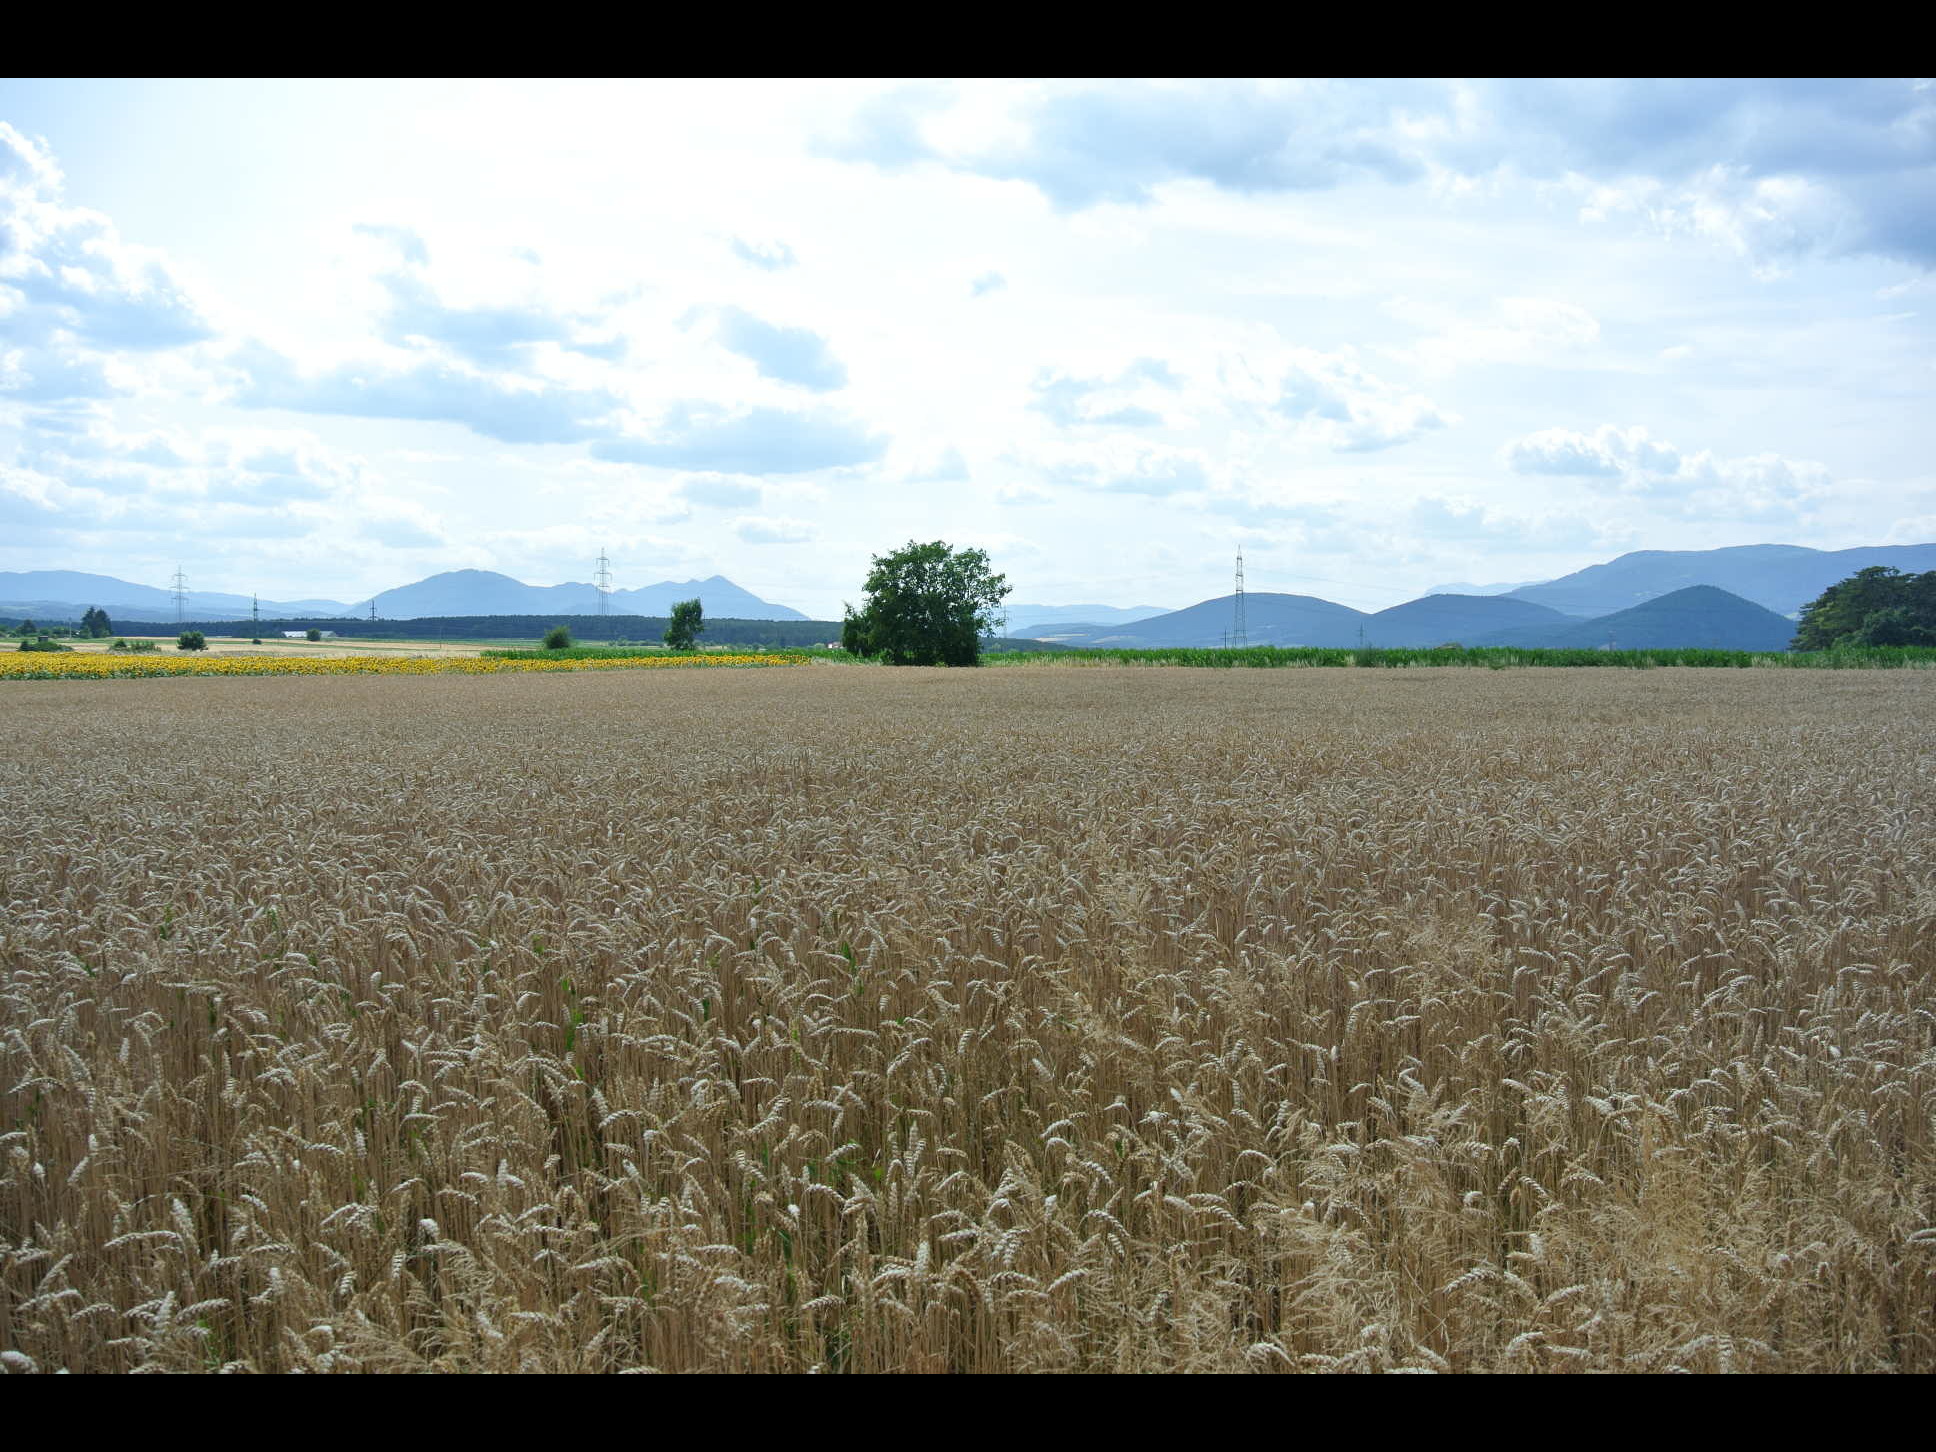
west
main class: Cropland
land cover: Common wheat
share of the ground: > 75 %
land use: Agriculture (excluding fallow land and kitchen gardens)
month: July
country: AT
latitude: 47.7135
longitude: 16.0677
